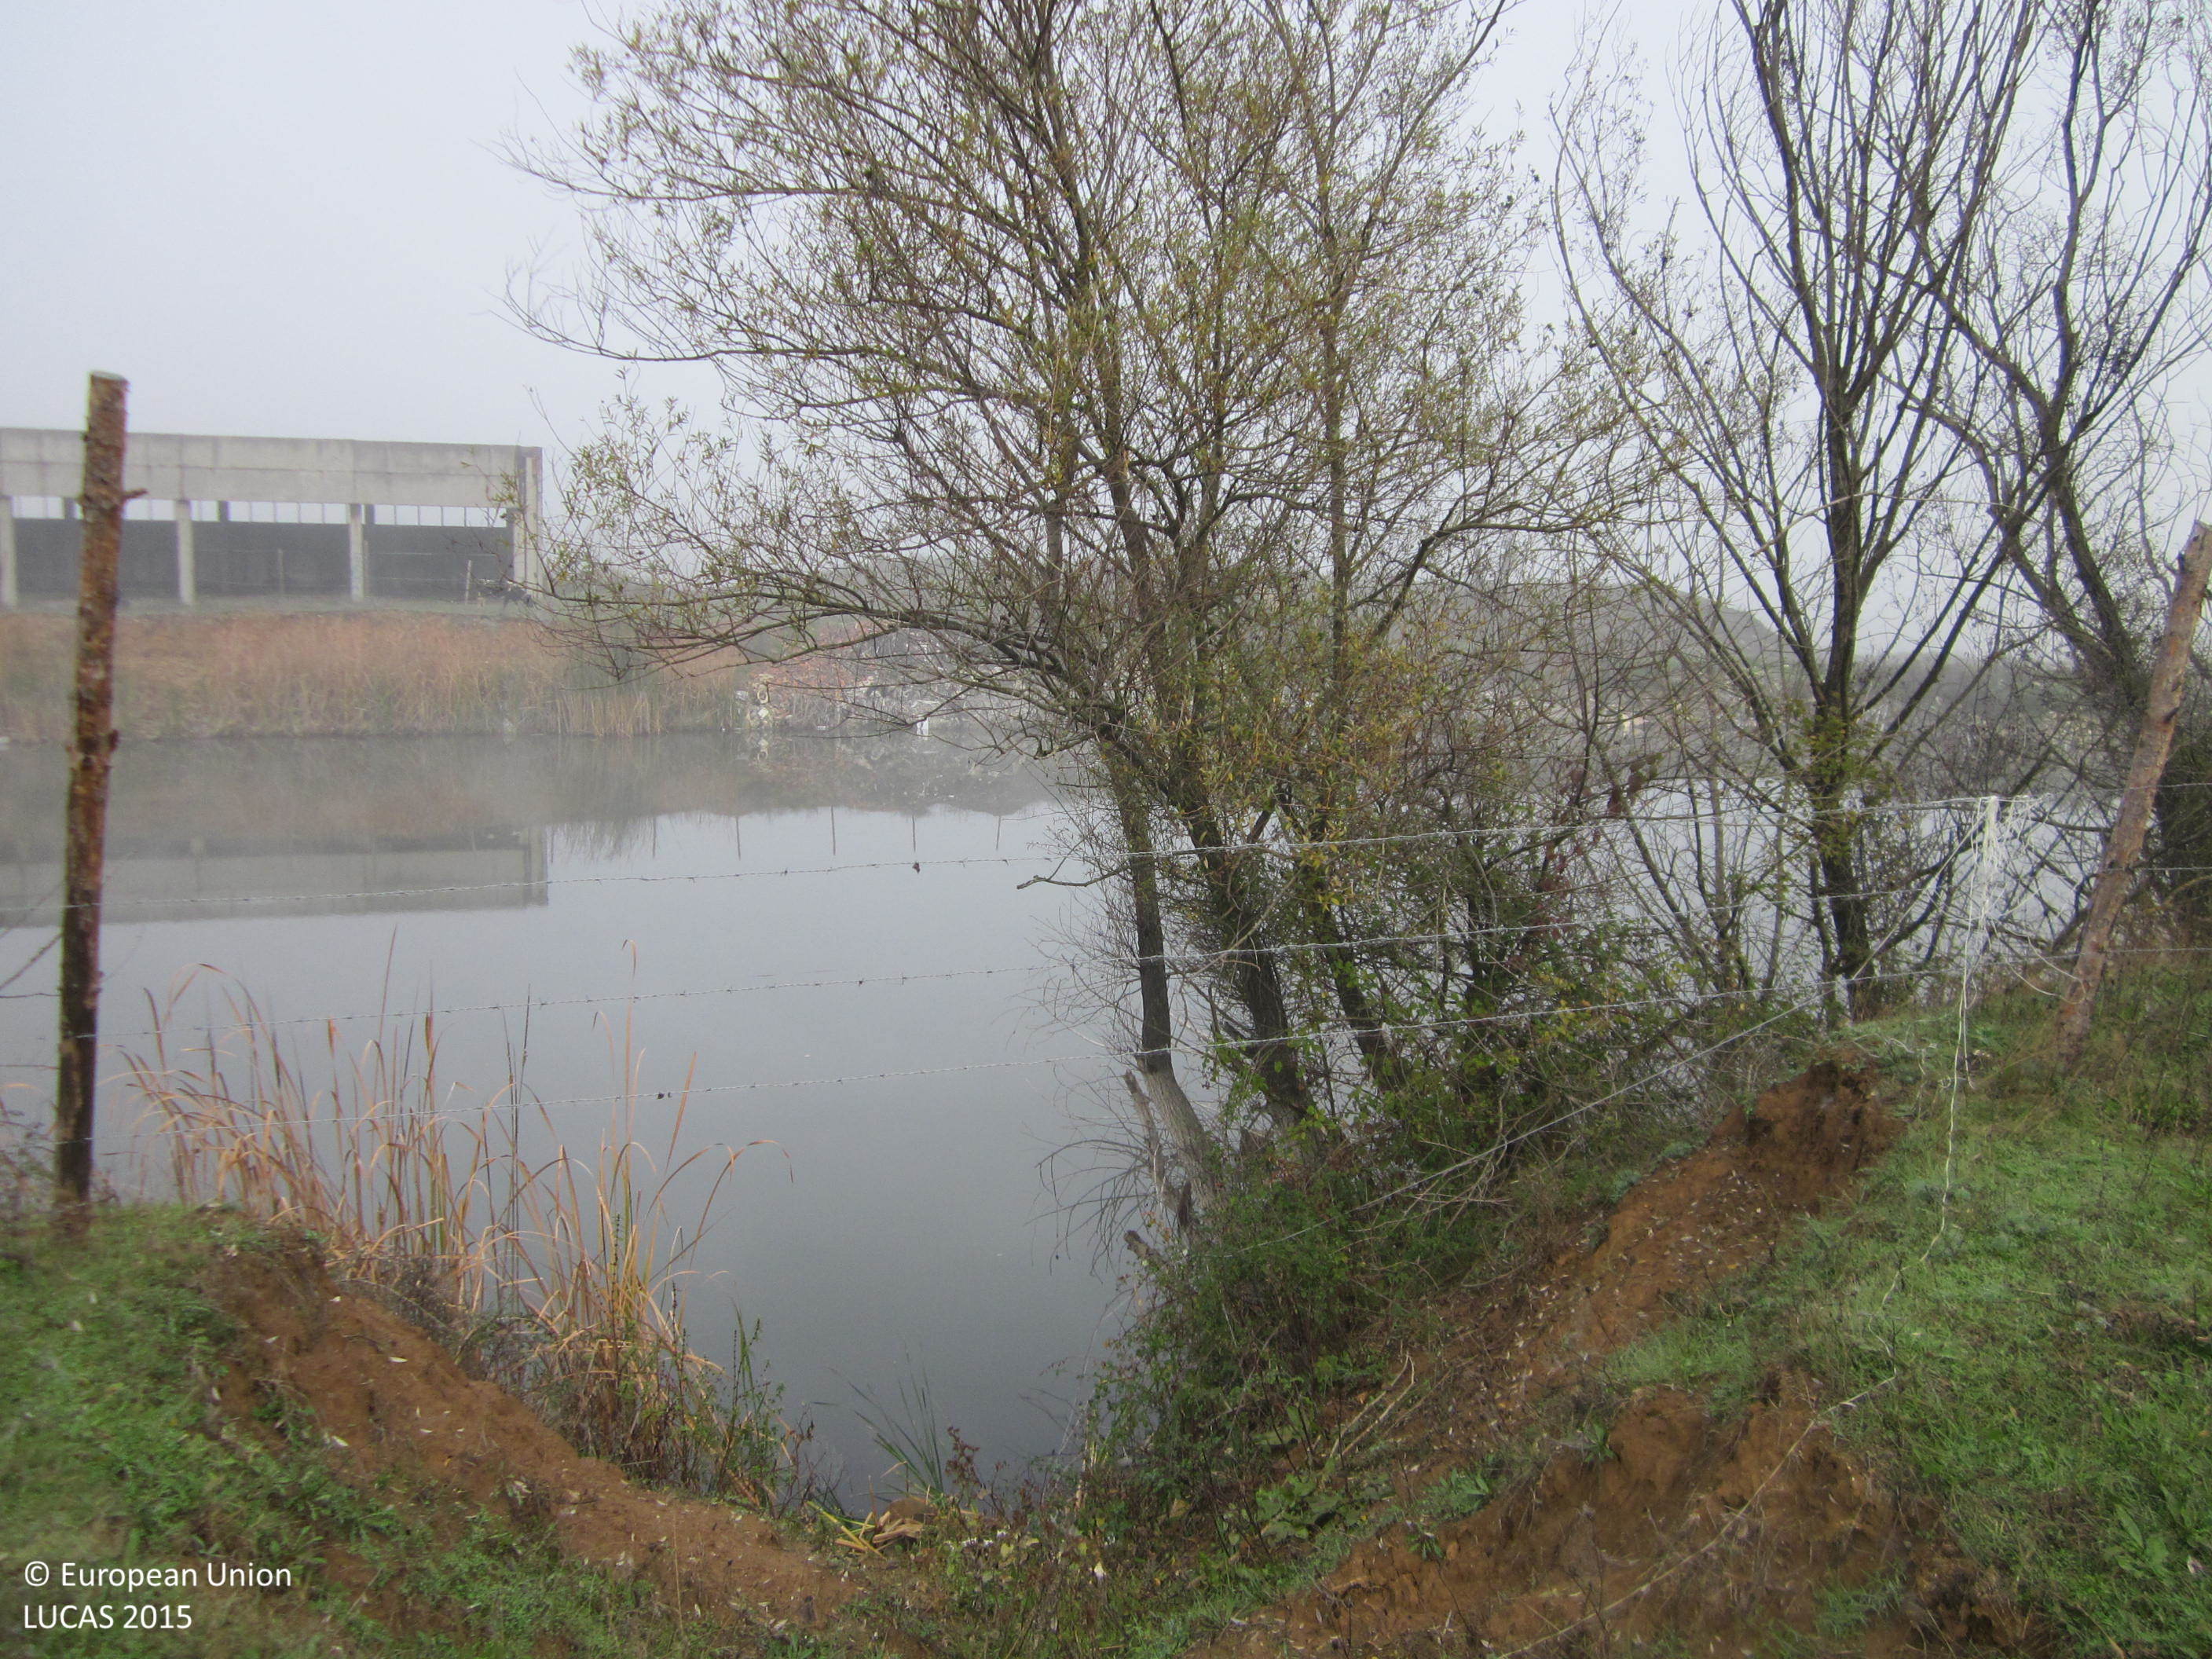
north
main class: Grassland
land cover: Grassland without tree/shrub cover
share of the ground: > 75 %
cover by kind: herbaceous plants 100 %
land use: Agriculture (excluding fallow land and kitchen gardens)
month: October
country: BG
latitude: 41.4675
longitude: 25.6373
